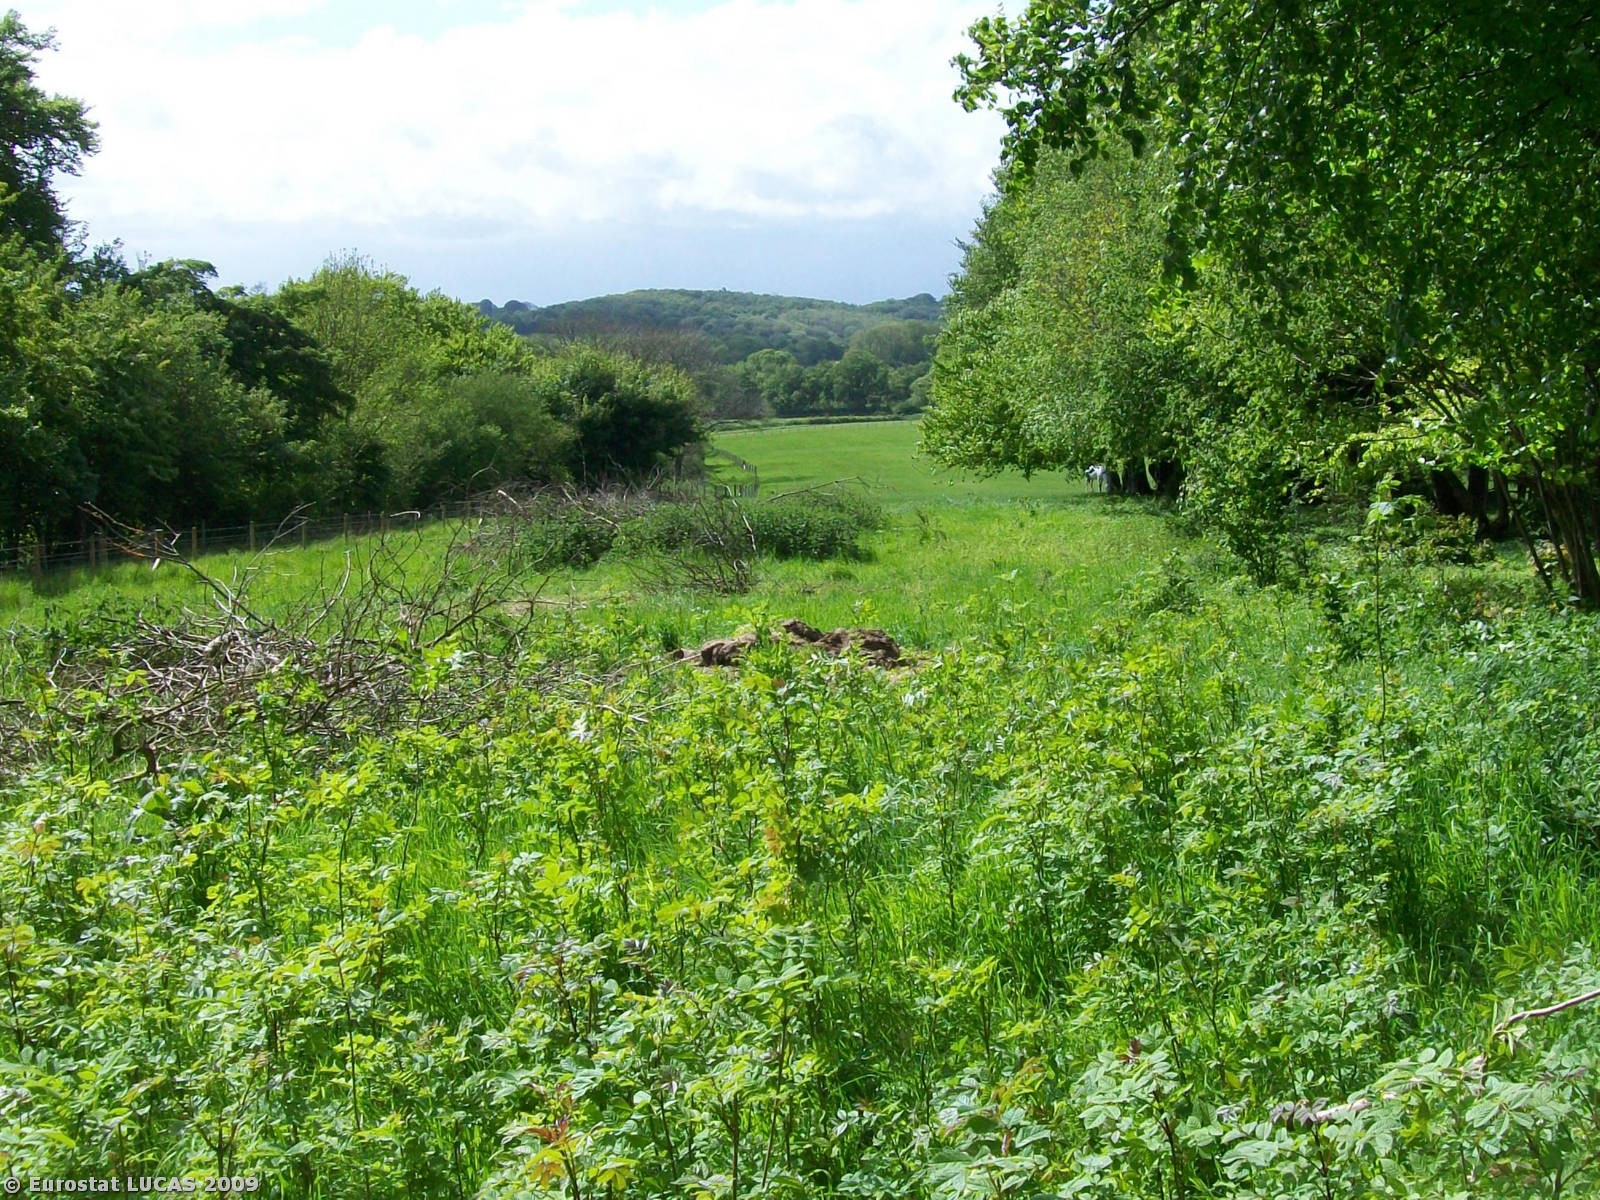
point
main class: Grassland
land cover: Grassland without tree/shrub cover
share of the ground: > 75 %
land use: Agriculture (excluding fallow land and kitchen gardens)
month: May
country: GB
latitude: 51.0775
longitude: -2.1504
